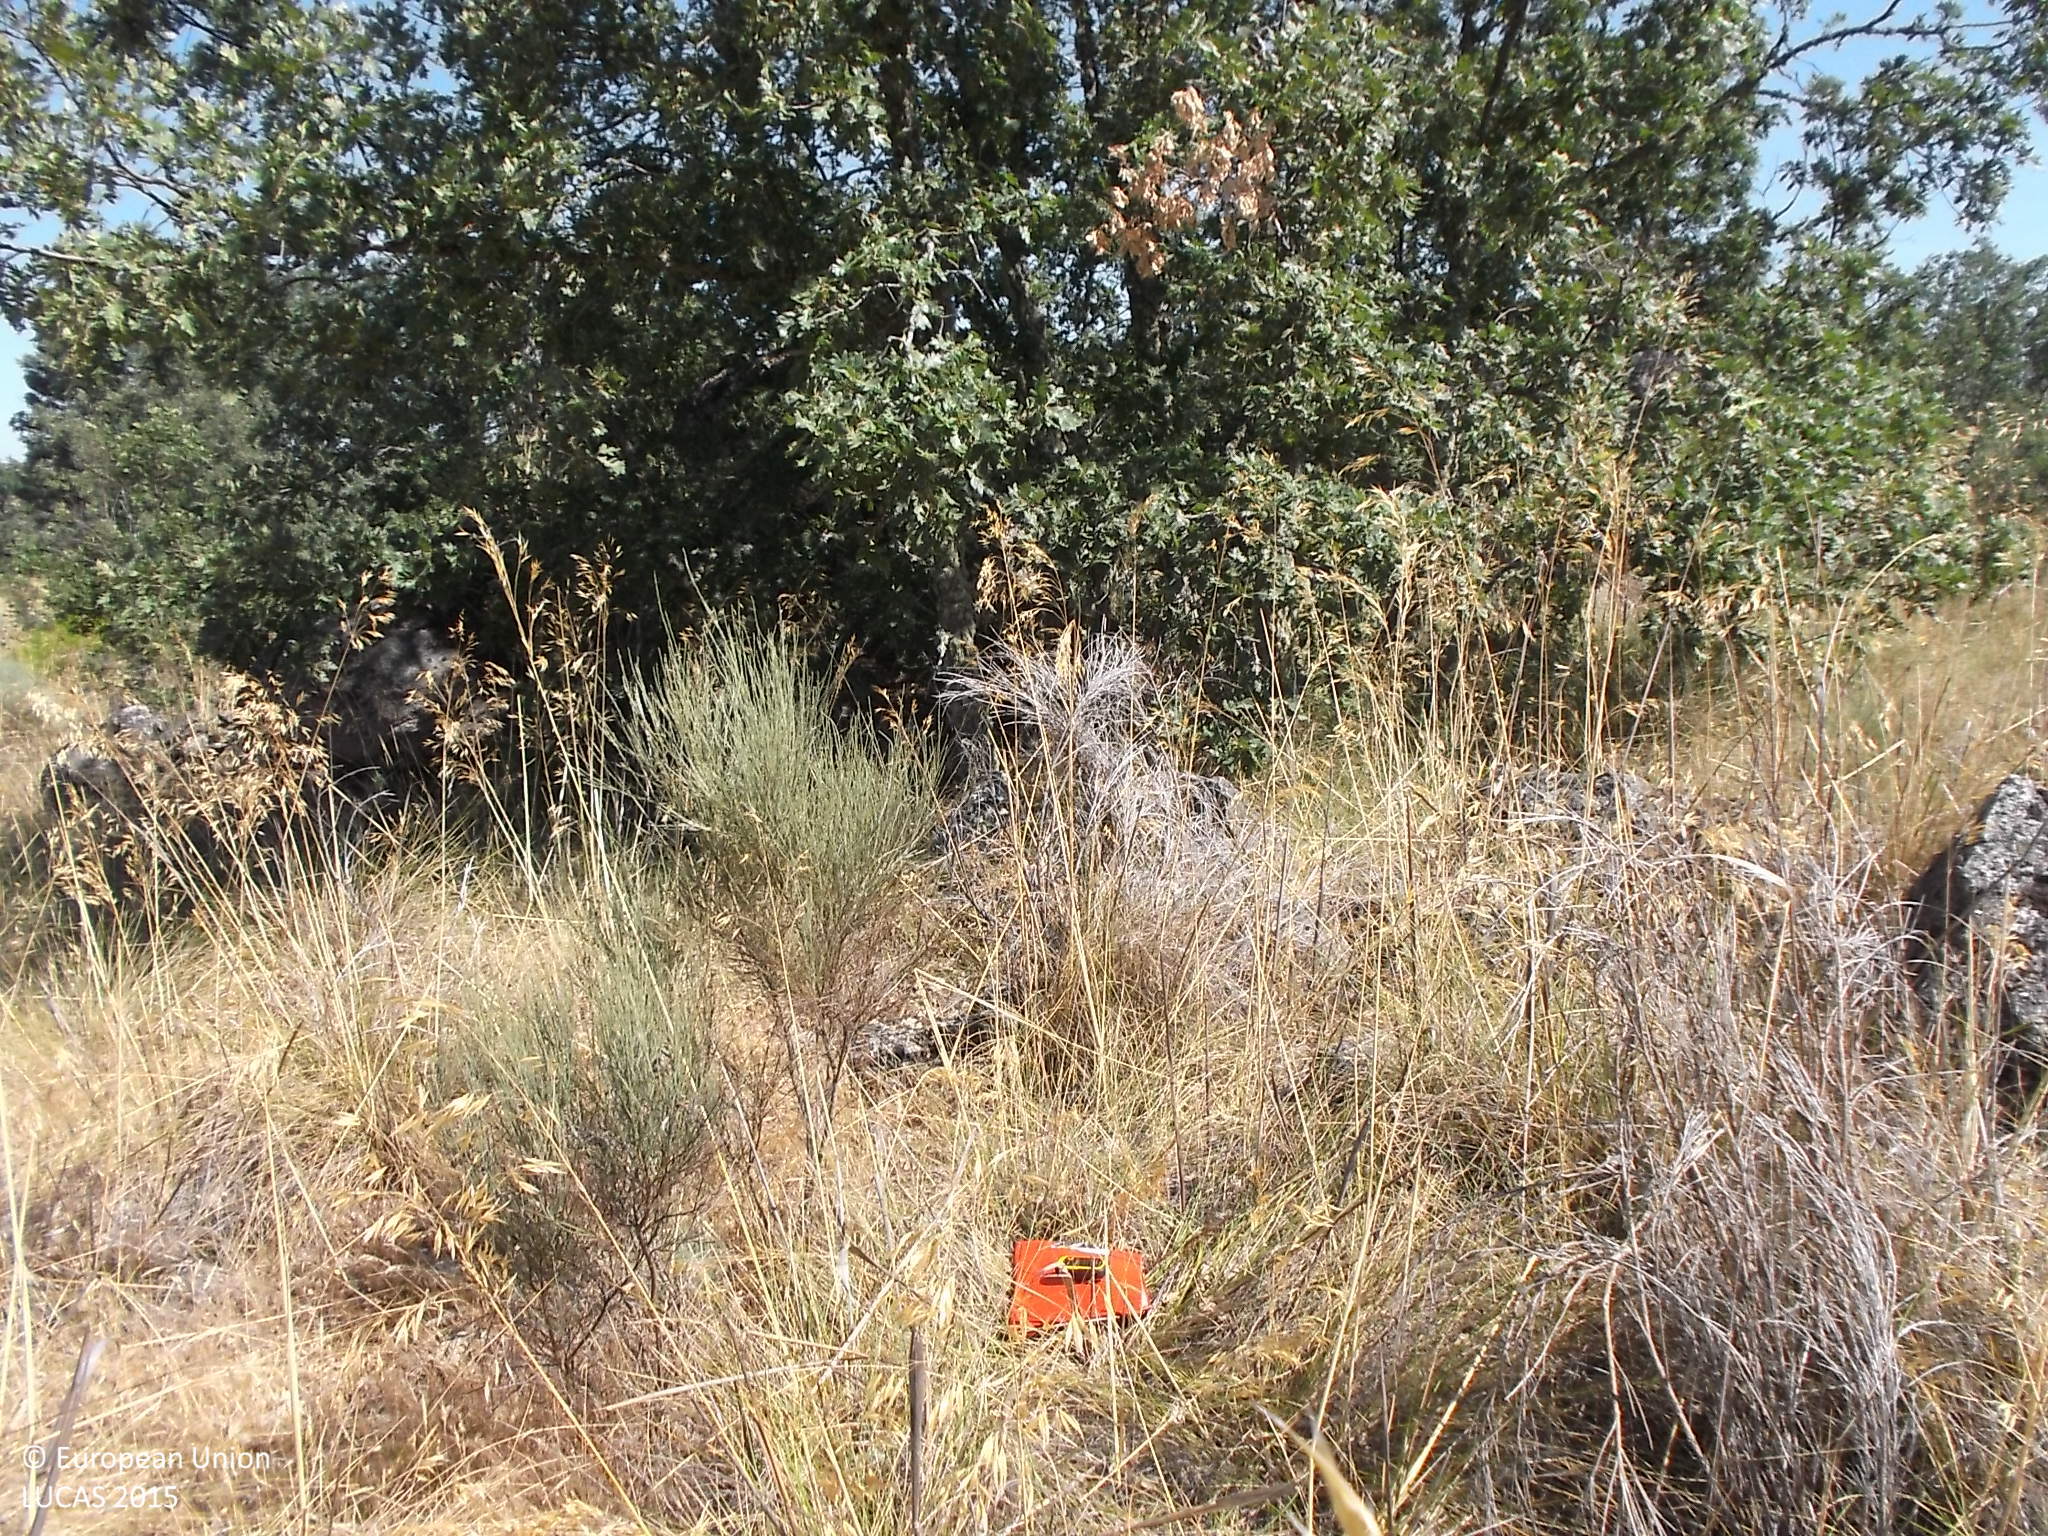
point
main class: Shrubland
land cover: Shrubland with sparse tree cover
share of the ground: > 75 %
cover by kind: shrubs 80 %, herbaceous plants 15 %, broadleaved forest trees 5 %
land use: Agriculture (excluding fallow land and kitchen gardens)
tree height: < 5 m
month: July
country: ES
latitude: 41.2203
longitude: -6.4756
